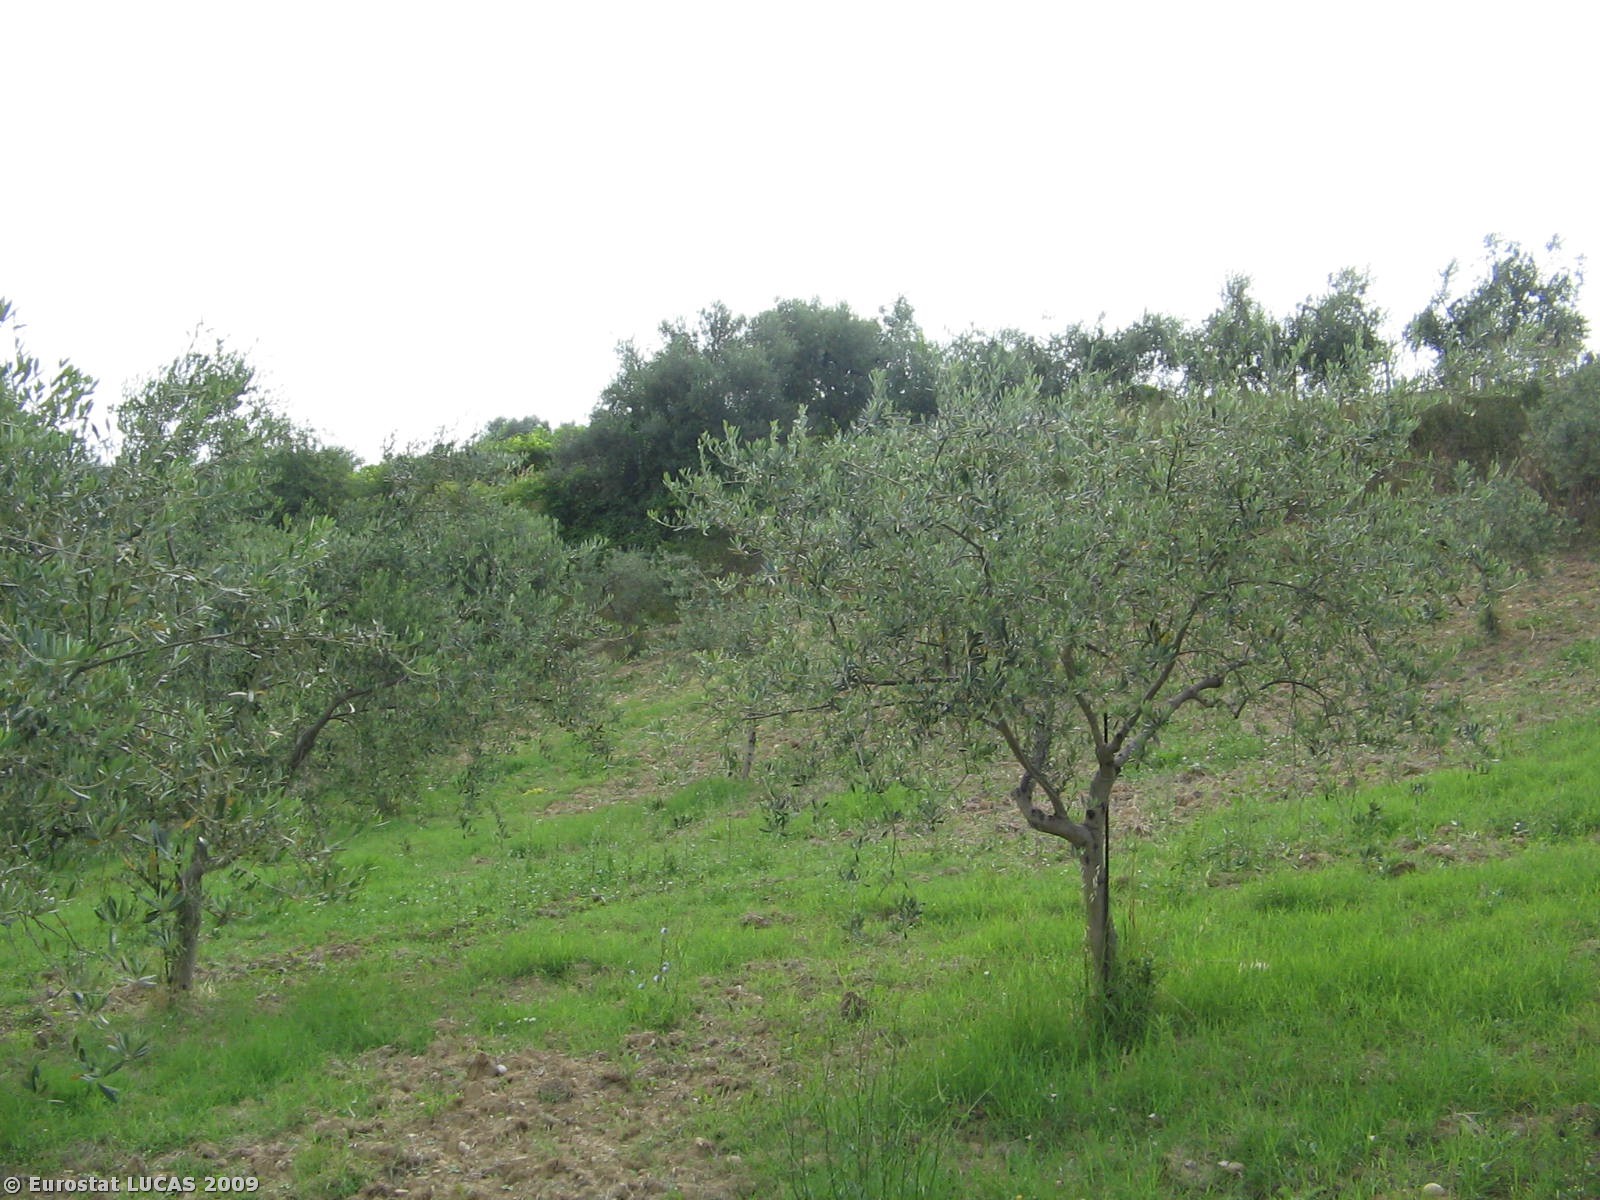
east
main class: Cropland
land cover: Olive groves
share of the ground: 10 - 25 %
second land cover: Grassland with sparse tree/shrub cover
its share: > 75 %
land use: Agriculture (excluding fallow land and kitchen gardens)
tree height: < 5 m
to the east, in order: Olive groves; Grassland with sparse tree/shrub cover; Abandoned hedges; Tracks; Olive groves; Grassland with sparse tree/shrub cover; Vineyards; Grassland with sparse tree/shrub cover; Single bushes/trees; Artificial constructions in urban areas
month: July
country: IT
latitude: 42.2685
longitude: 14.4119
